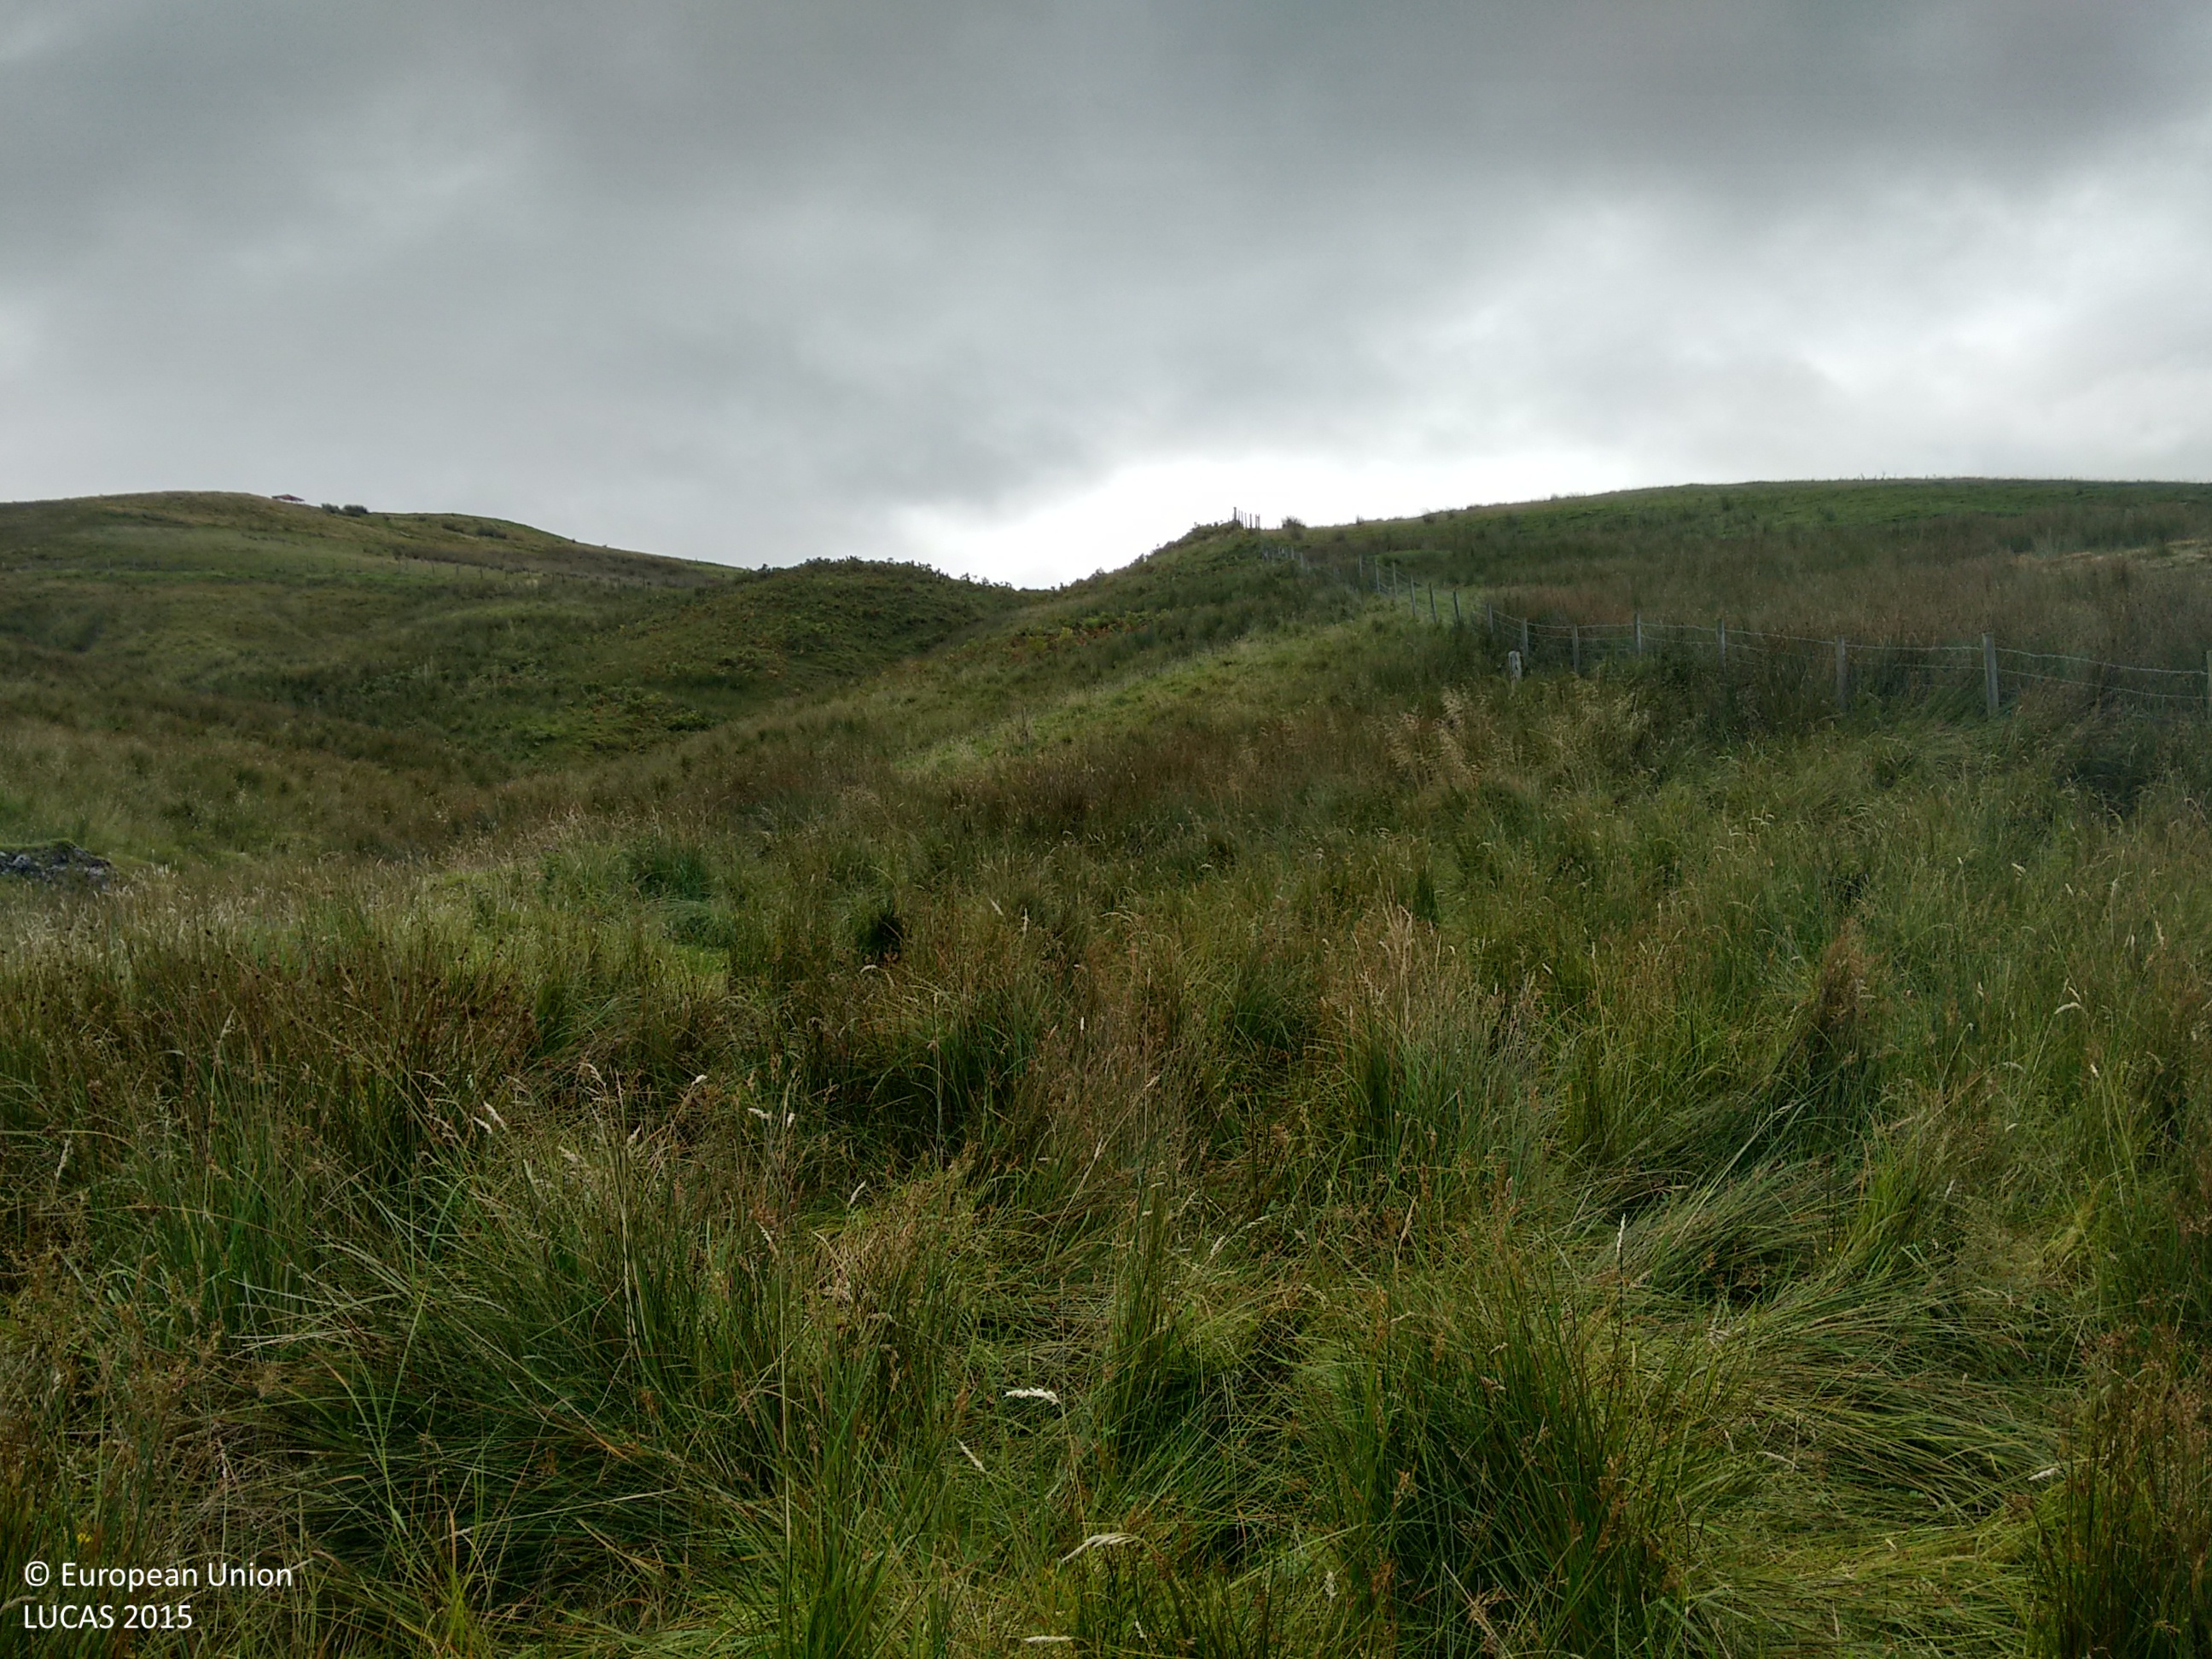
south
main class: Grassland
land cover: Grassland without tree/shrub cover
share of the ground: > 75 %
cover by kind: herbaceous plants 100 %
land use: Agriculture (excluding fallow land and kitchen gardens)
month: September
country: GB
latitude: 55.4077
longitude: -5.7514
